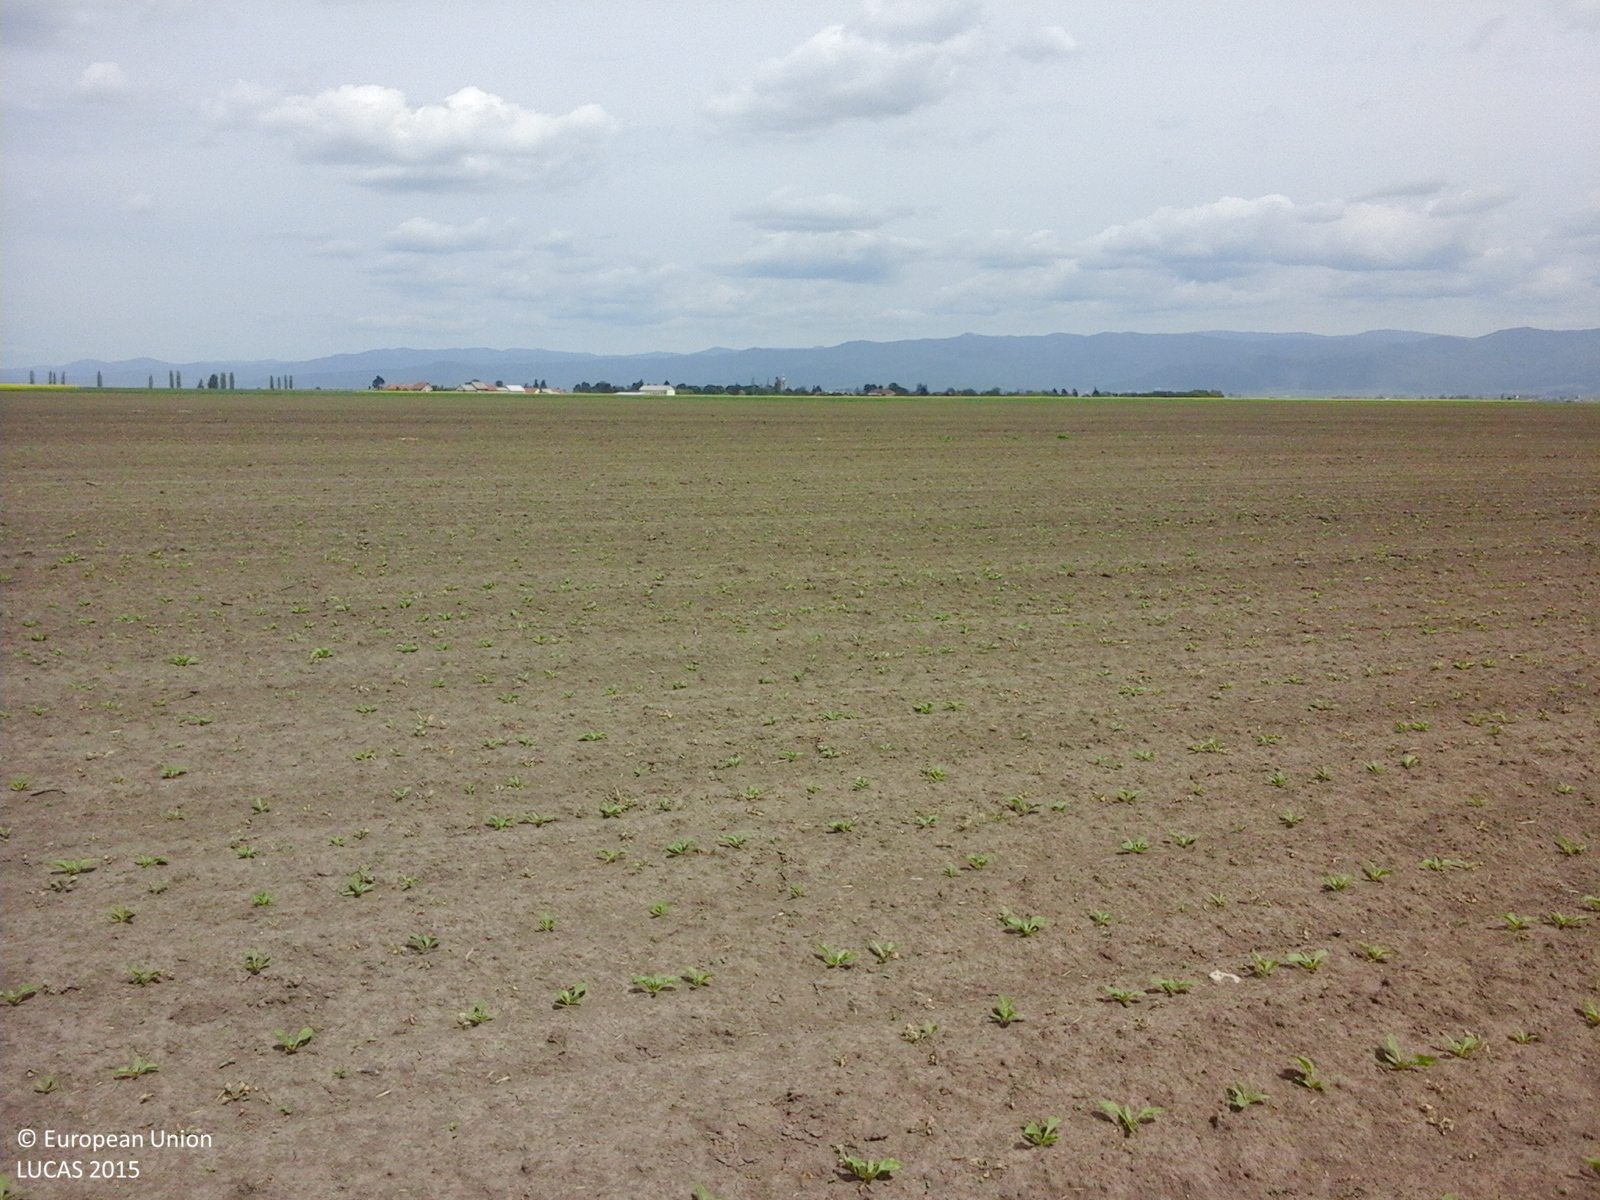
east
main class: Cropland
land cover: Sugar beet
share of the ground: < 10 %
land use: Agriculture (excluding fallow land and kitchen gardens)
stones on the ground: < 10 %
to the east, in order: Sugar beet
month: May
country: RO
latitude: 45.8532
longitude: 25.9948
